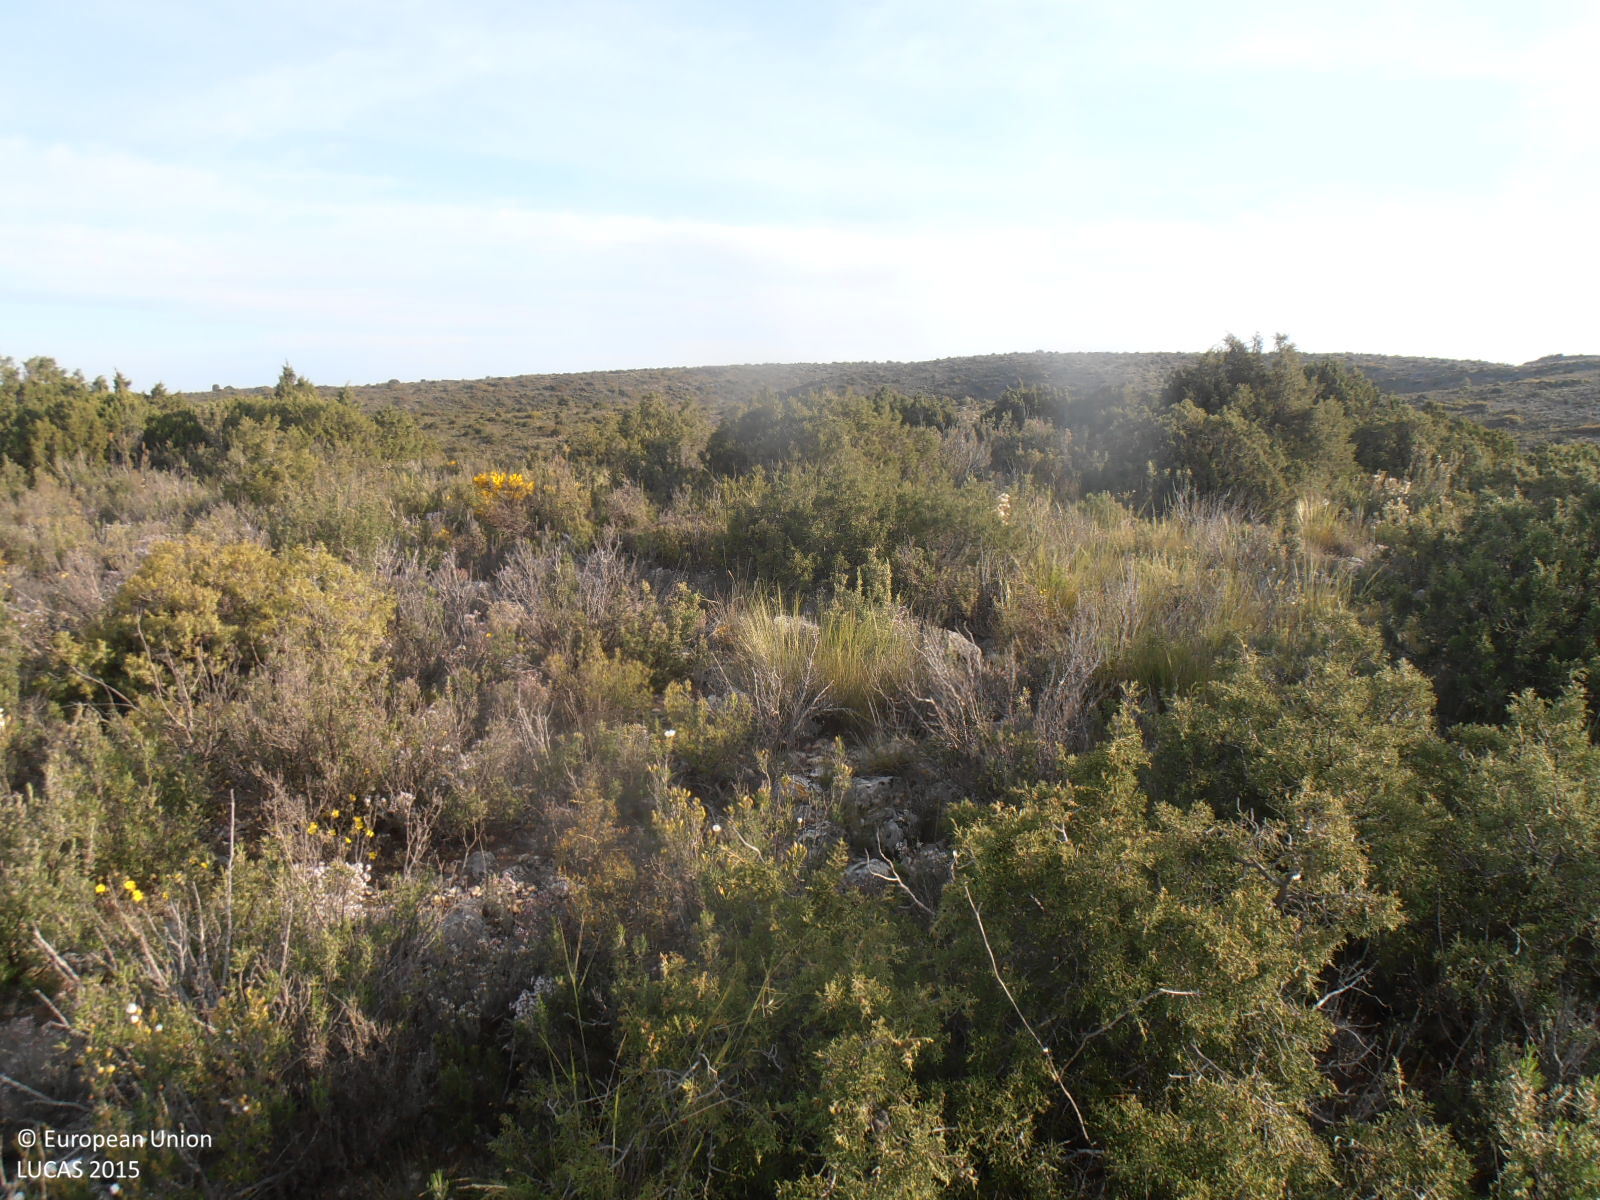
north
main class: Shrubland
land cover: Shrubland with sparse tree cover
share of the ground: > 75 %
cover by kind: shrubs 80 %, consolidated bare surface 10 %, coniferous forest trees 5 %, herbaceous plants 5 %
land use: Semi-natural and natural areas not in use
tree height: < 5 m
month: April
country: ES
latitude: 41.3959
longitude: -1.0120
